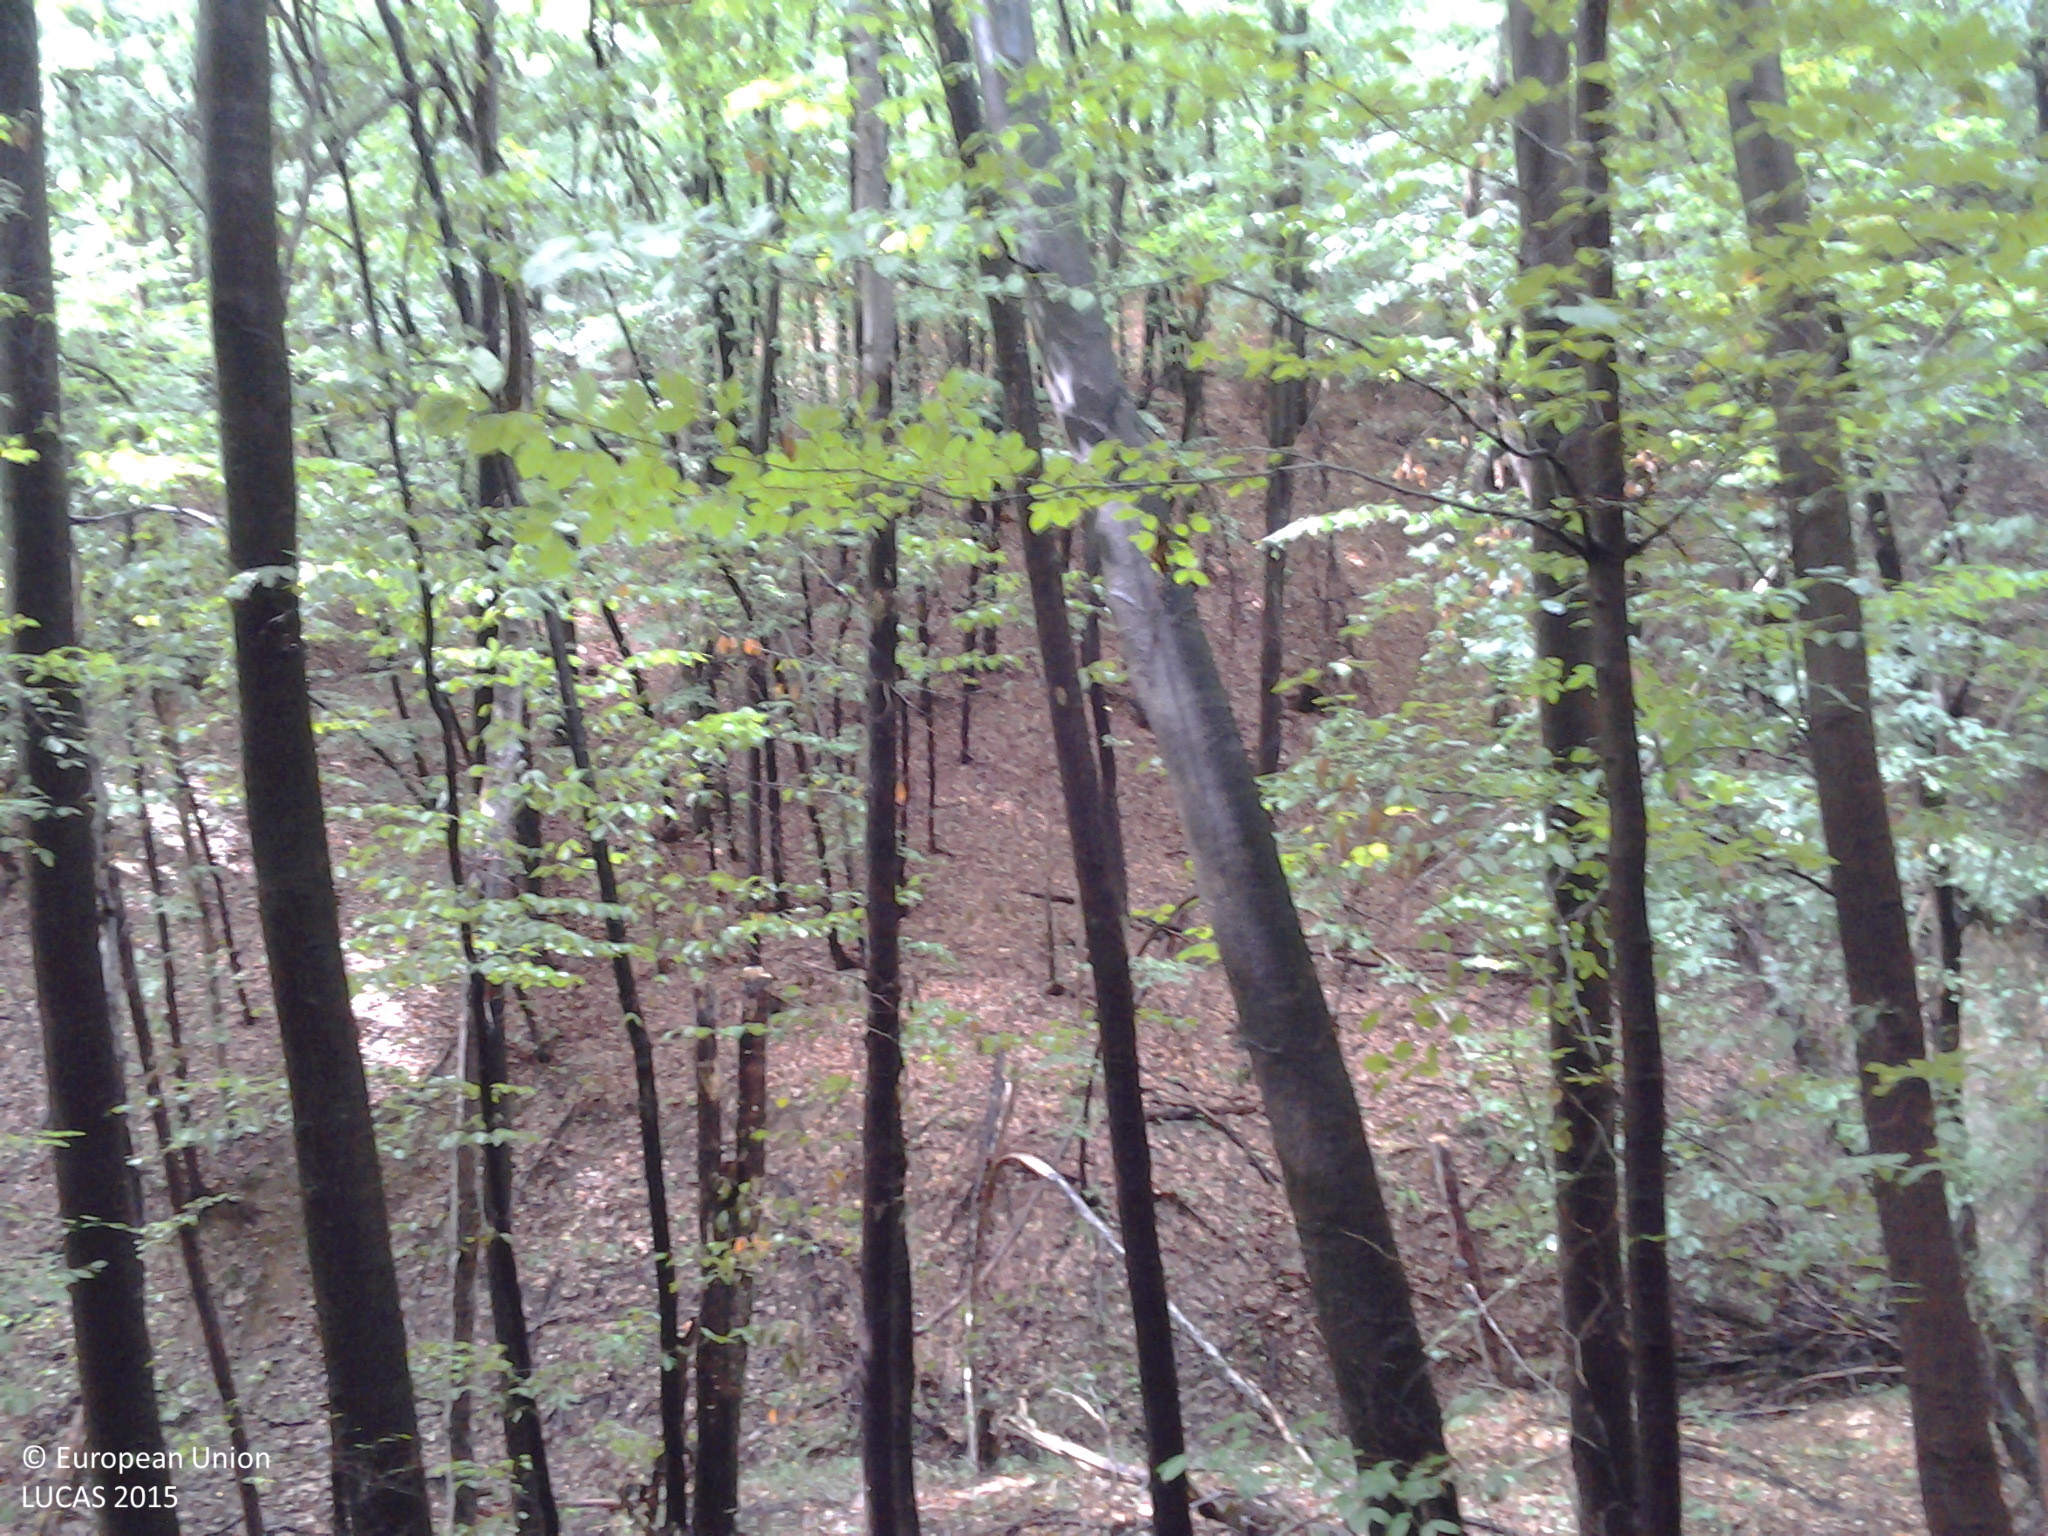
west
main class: Woodland
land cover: Broadleaved woodland
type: beech forest
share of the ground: > 75 %
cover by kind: broadleaved forest trees 100 %
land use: Forestry
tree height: > 5 m
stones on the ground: 10 - 25 %
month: September
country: RO
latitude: 46.9797
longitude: 22.6639
